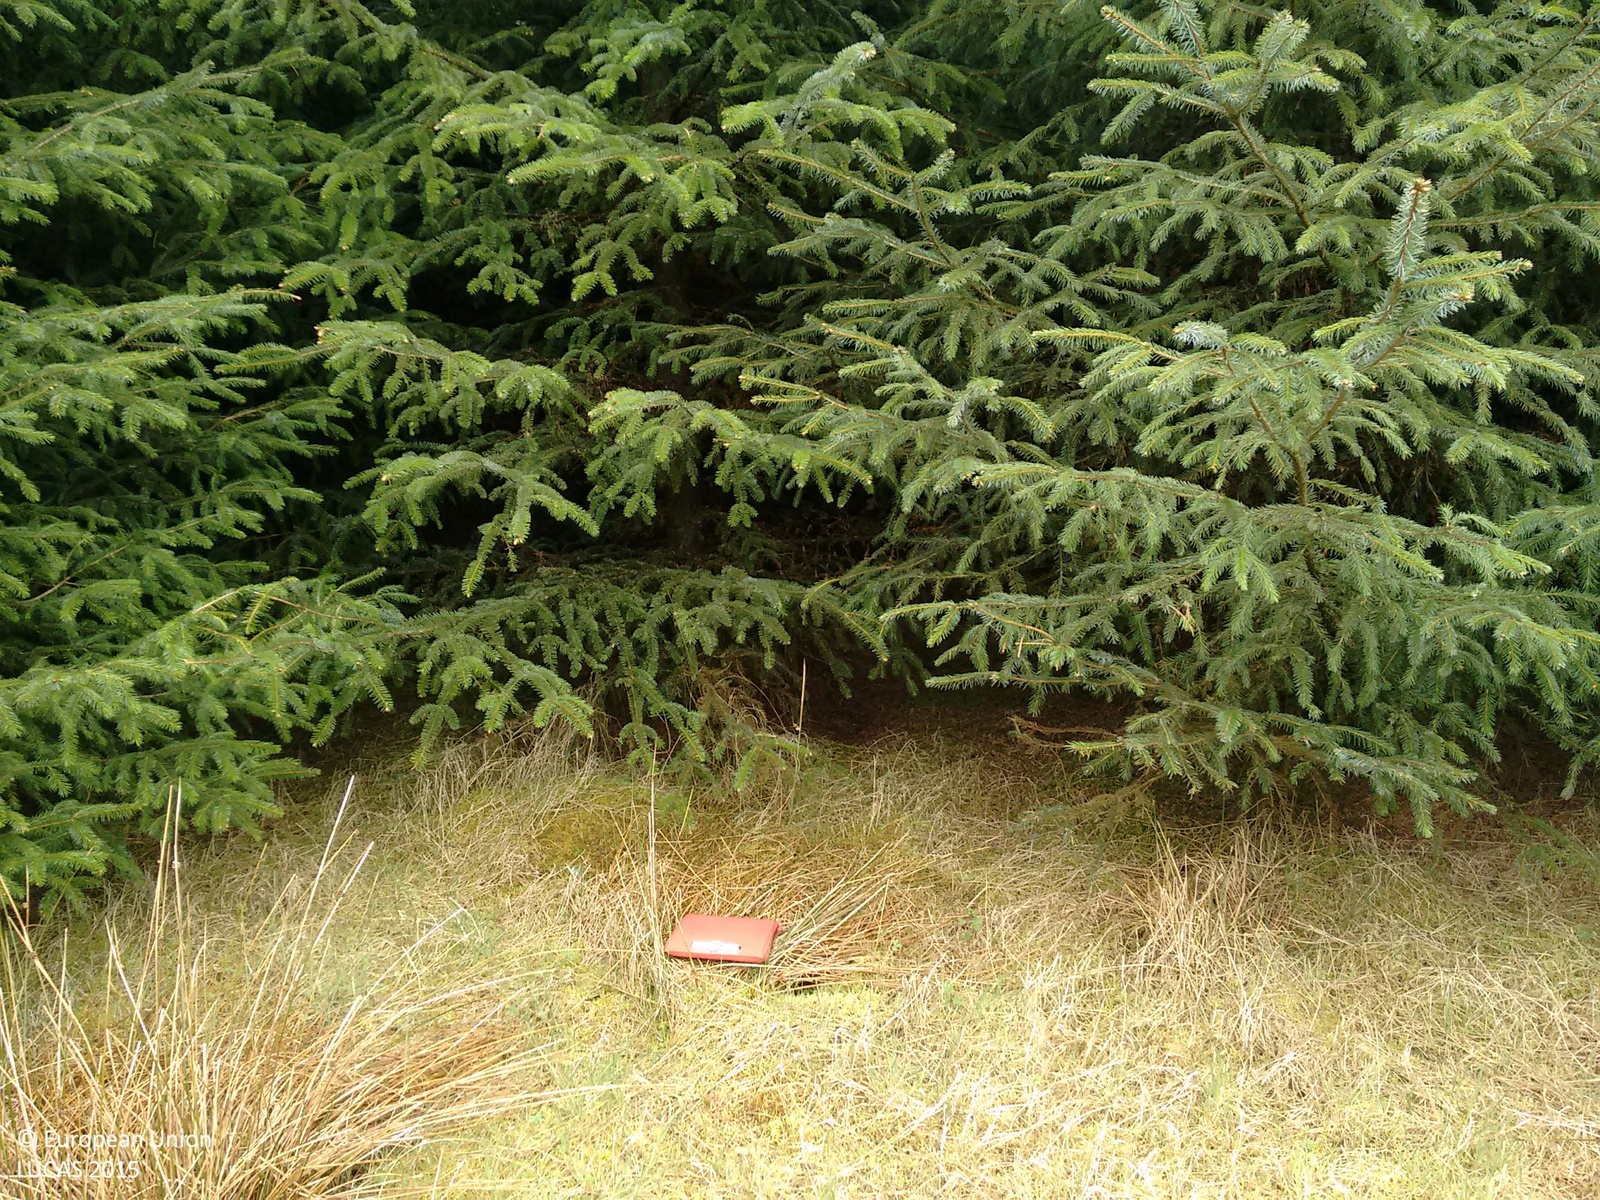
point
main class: Woodland
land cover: Spruce dominated coniferous woodland
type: hemiboreal forest and nemoral coniferous forest and mixed broadleaved-coniferous forest
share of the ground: > 75 %
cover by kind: coniferous forest trees 100 %
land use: Forestry
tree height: > 5 m
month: May
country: GB
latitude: 55.9167
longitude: -3.9263
